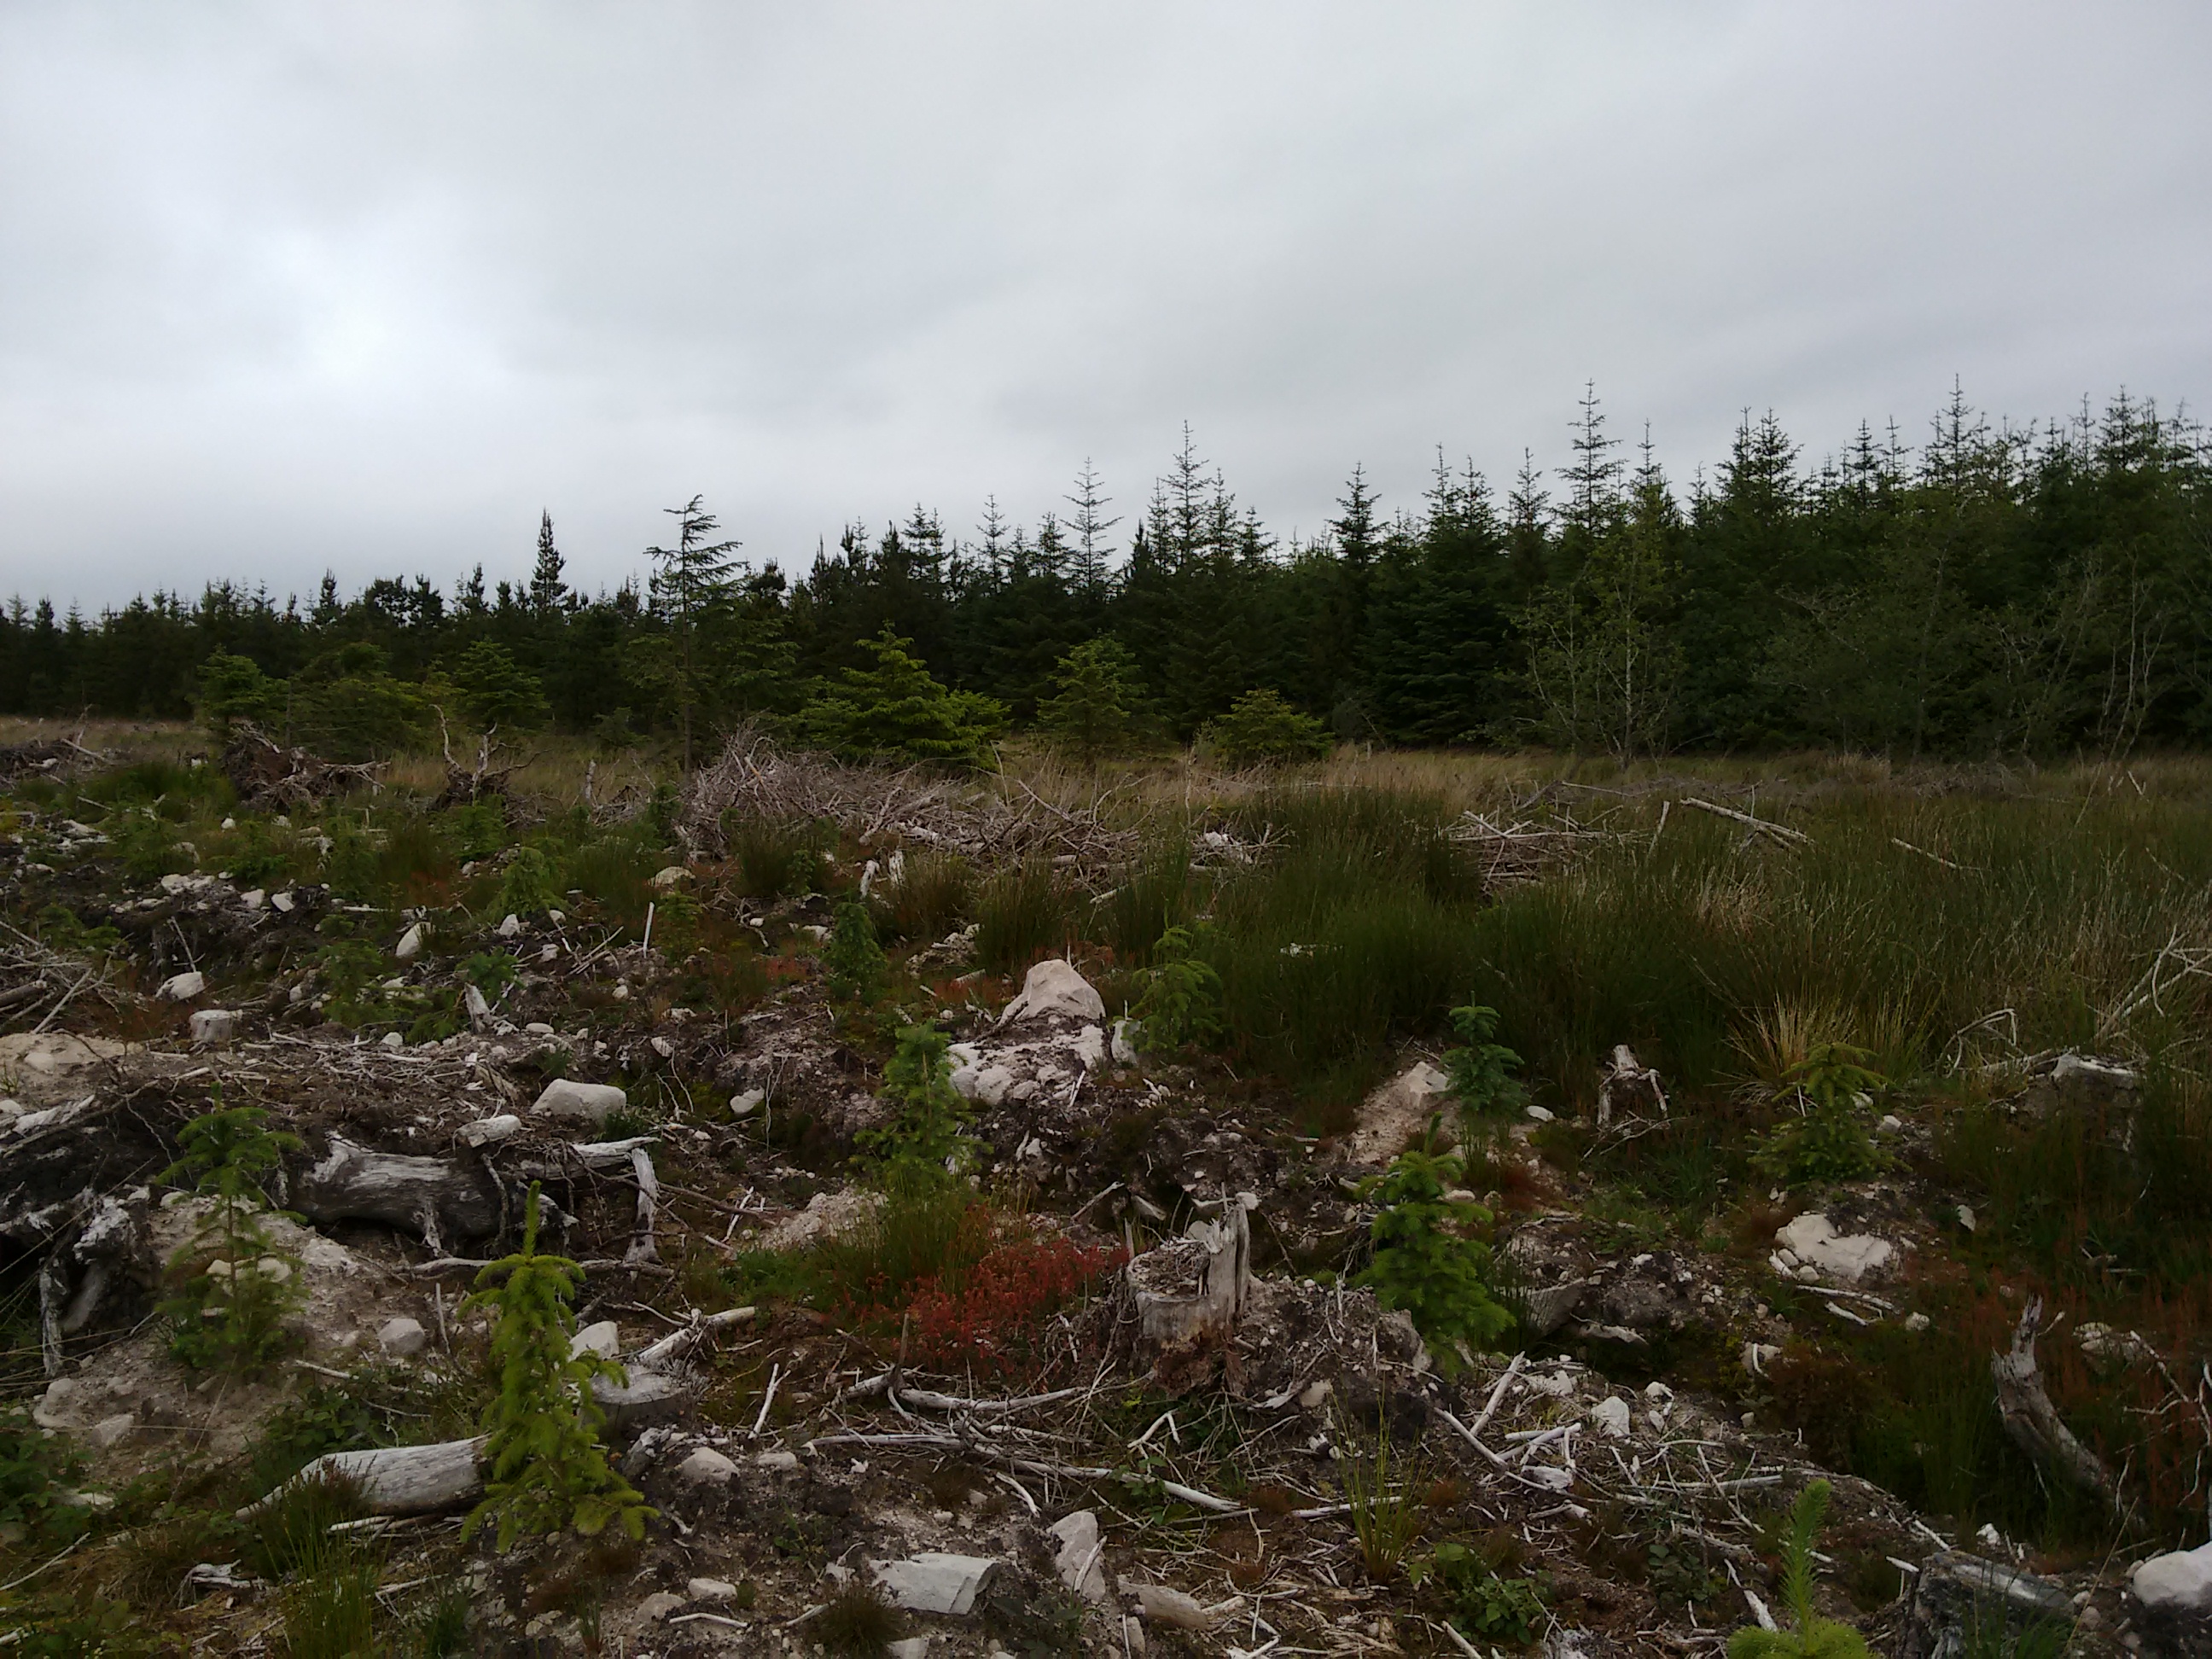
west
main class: Grassland
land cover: Grassland with sparse tree/shrub cover
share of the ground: > 75 %
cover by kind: herbaceous plants 35 %, lichens and mosses 10 %, broadleaved forest trees 5 %, shrubs 5 %
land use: Forestry
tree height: < 5 m
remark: Clear cut
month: June
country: IE
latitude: 53.0483
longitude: -8.4971
